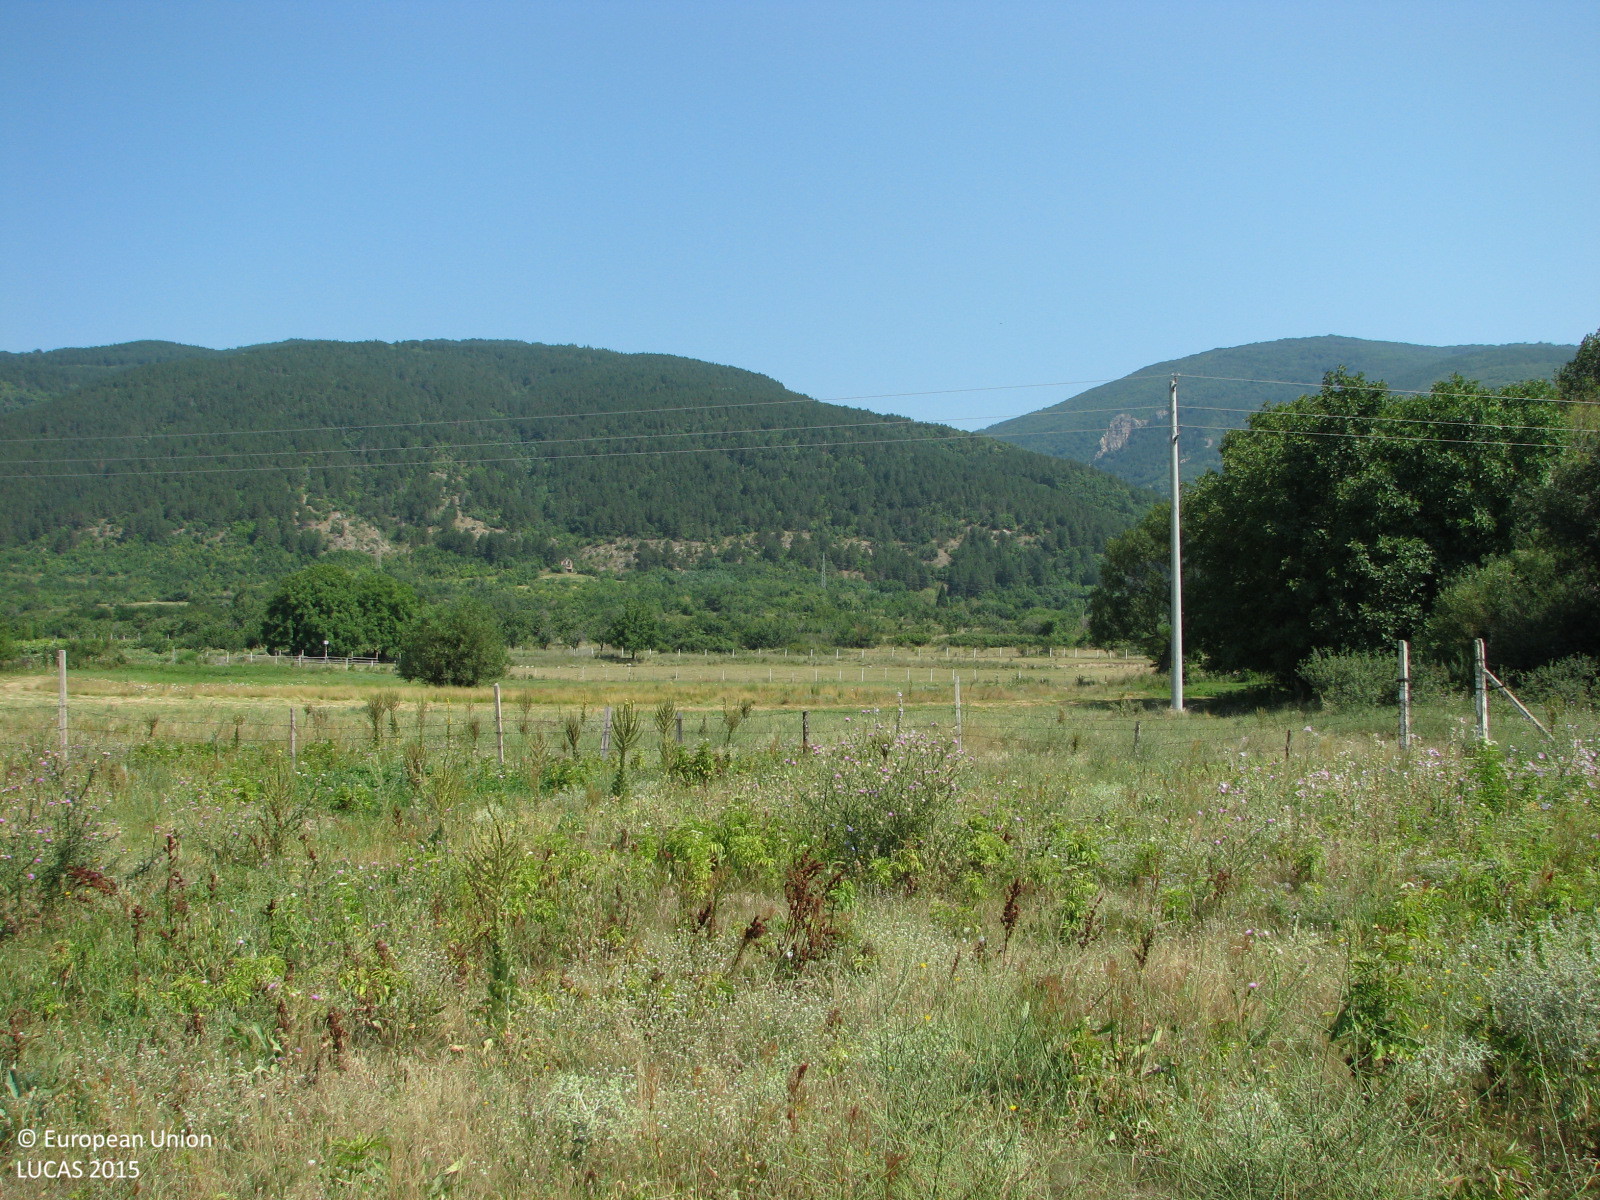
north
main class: Grassland
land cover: Grassland with sparse tree/shrub cover
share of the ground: > 75 %
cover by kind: herbaceous plants 90 %, broadleaved forest trees 5 %, shrubs 5 %
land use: Abandoned areas
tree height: < 5 m
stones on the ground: < 10 %
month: July
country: BG
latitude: 42.6871
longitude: 25.9360
